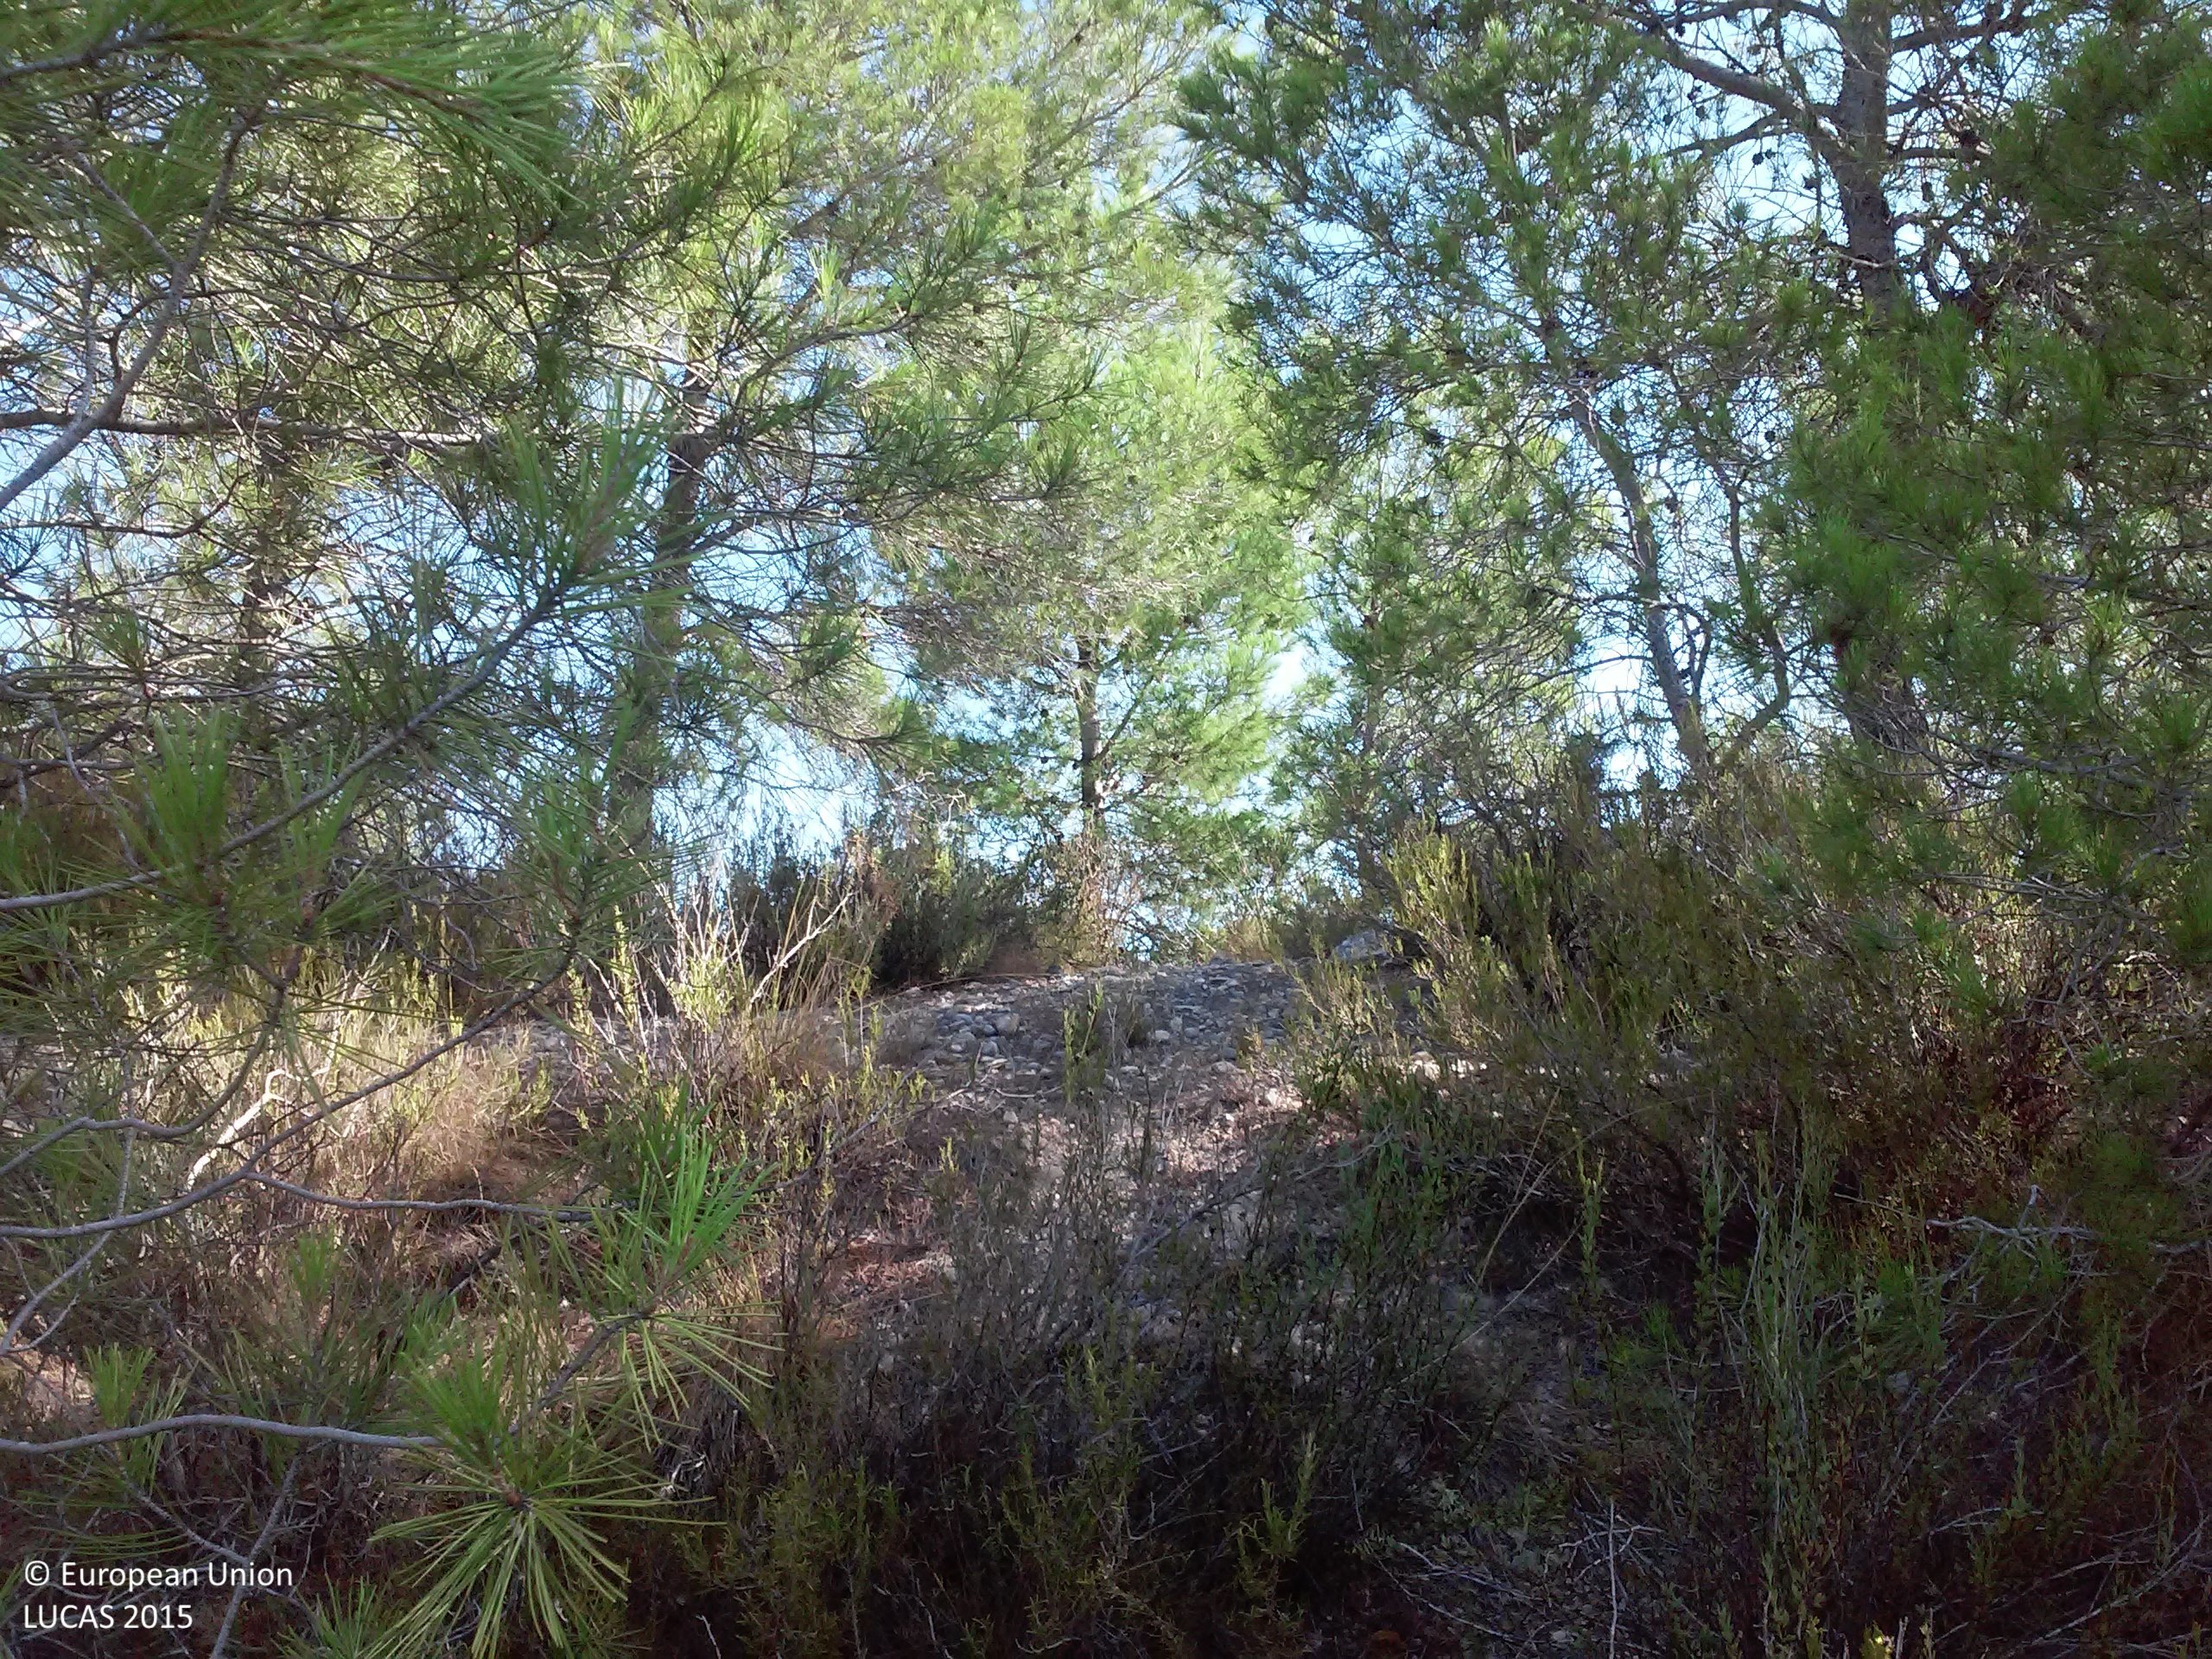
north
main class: Woodland
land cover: Pine dominated coniferous woodland
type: coniferous forest of the mediterranean region
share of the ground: 25 - 50 %
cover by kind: coniferous forest trees 40 %, shrubs 40 %, herbaceous plants 20 %
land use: Semi-natural and natural areas not in use
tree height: < 5 m
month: August
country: ES
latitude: 41.0866
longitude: 0.5756
